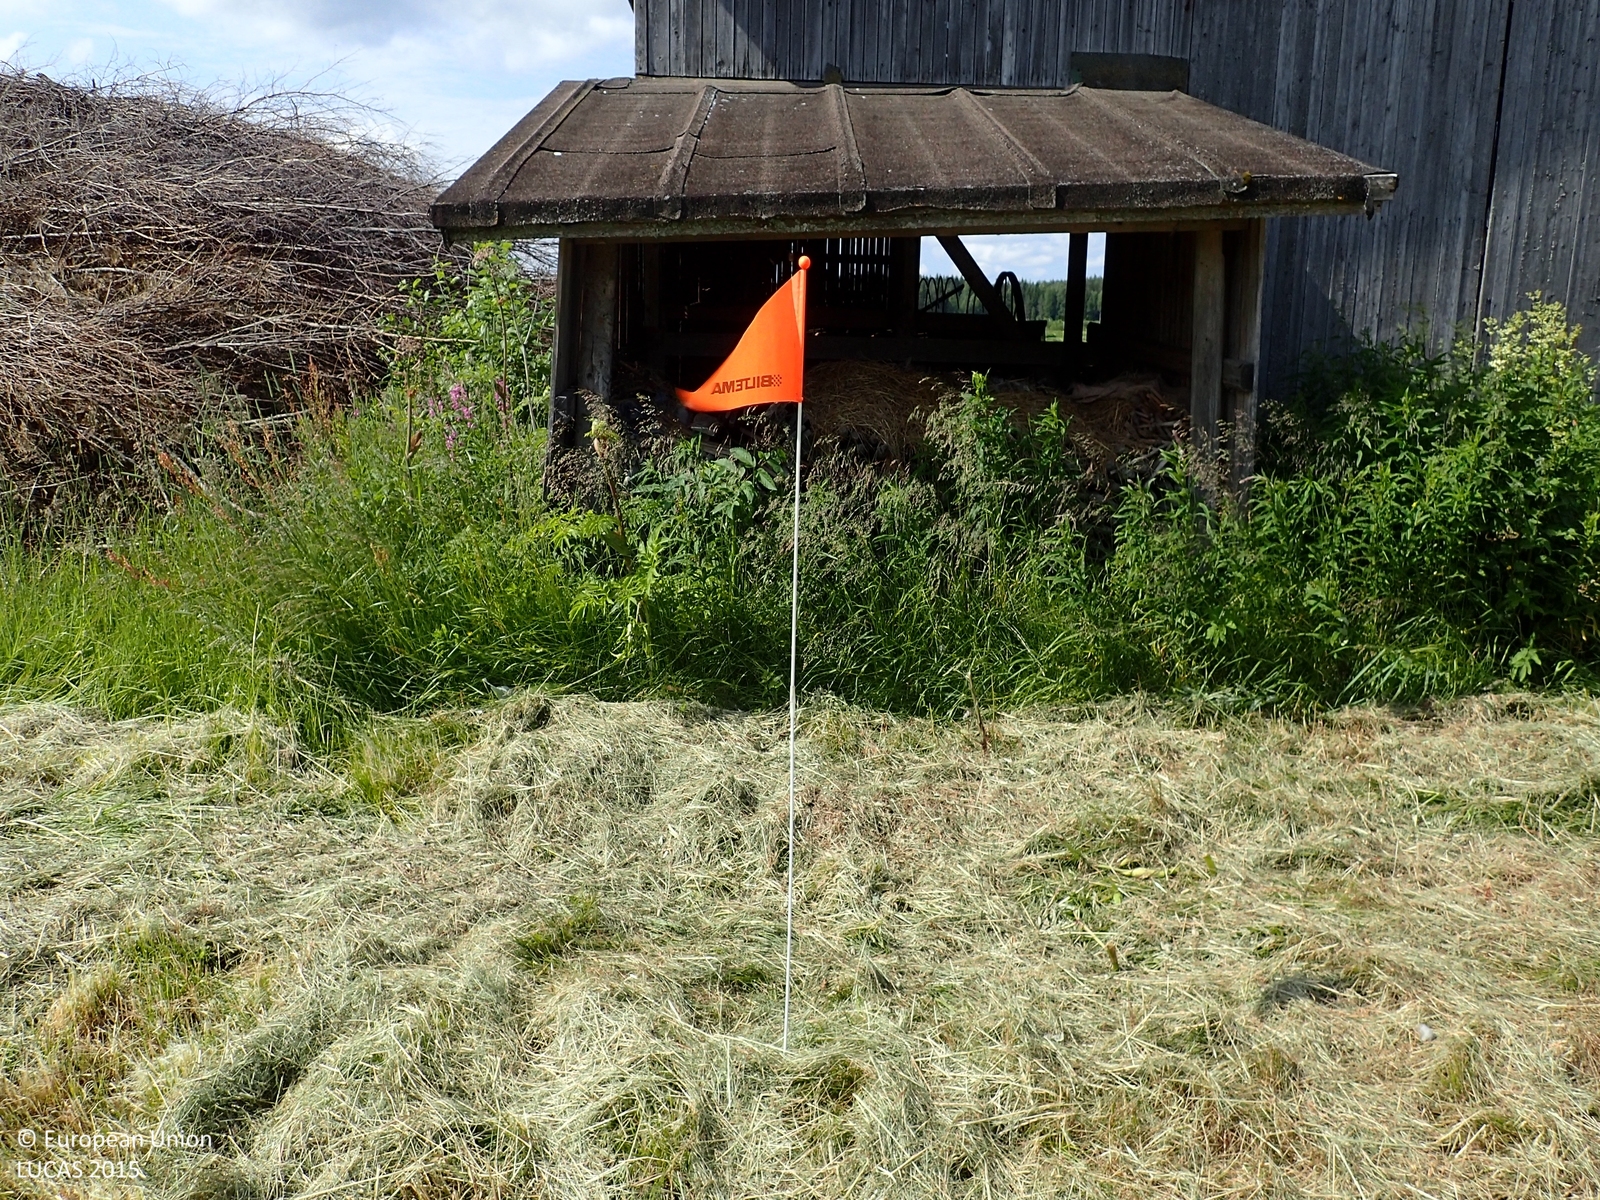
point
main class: Cropland
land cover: Temporary grasslands
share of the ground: > 75 %
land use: Agriculture (excluding fallow land and kitchen gardens)
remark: Harvested field
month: July
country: FI
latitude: 62.7585
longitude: 23.6416
